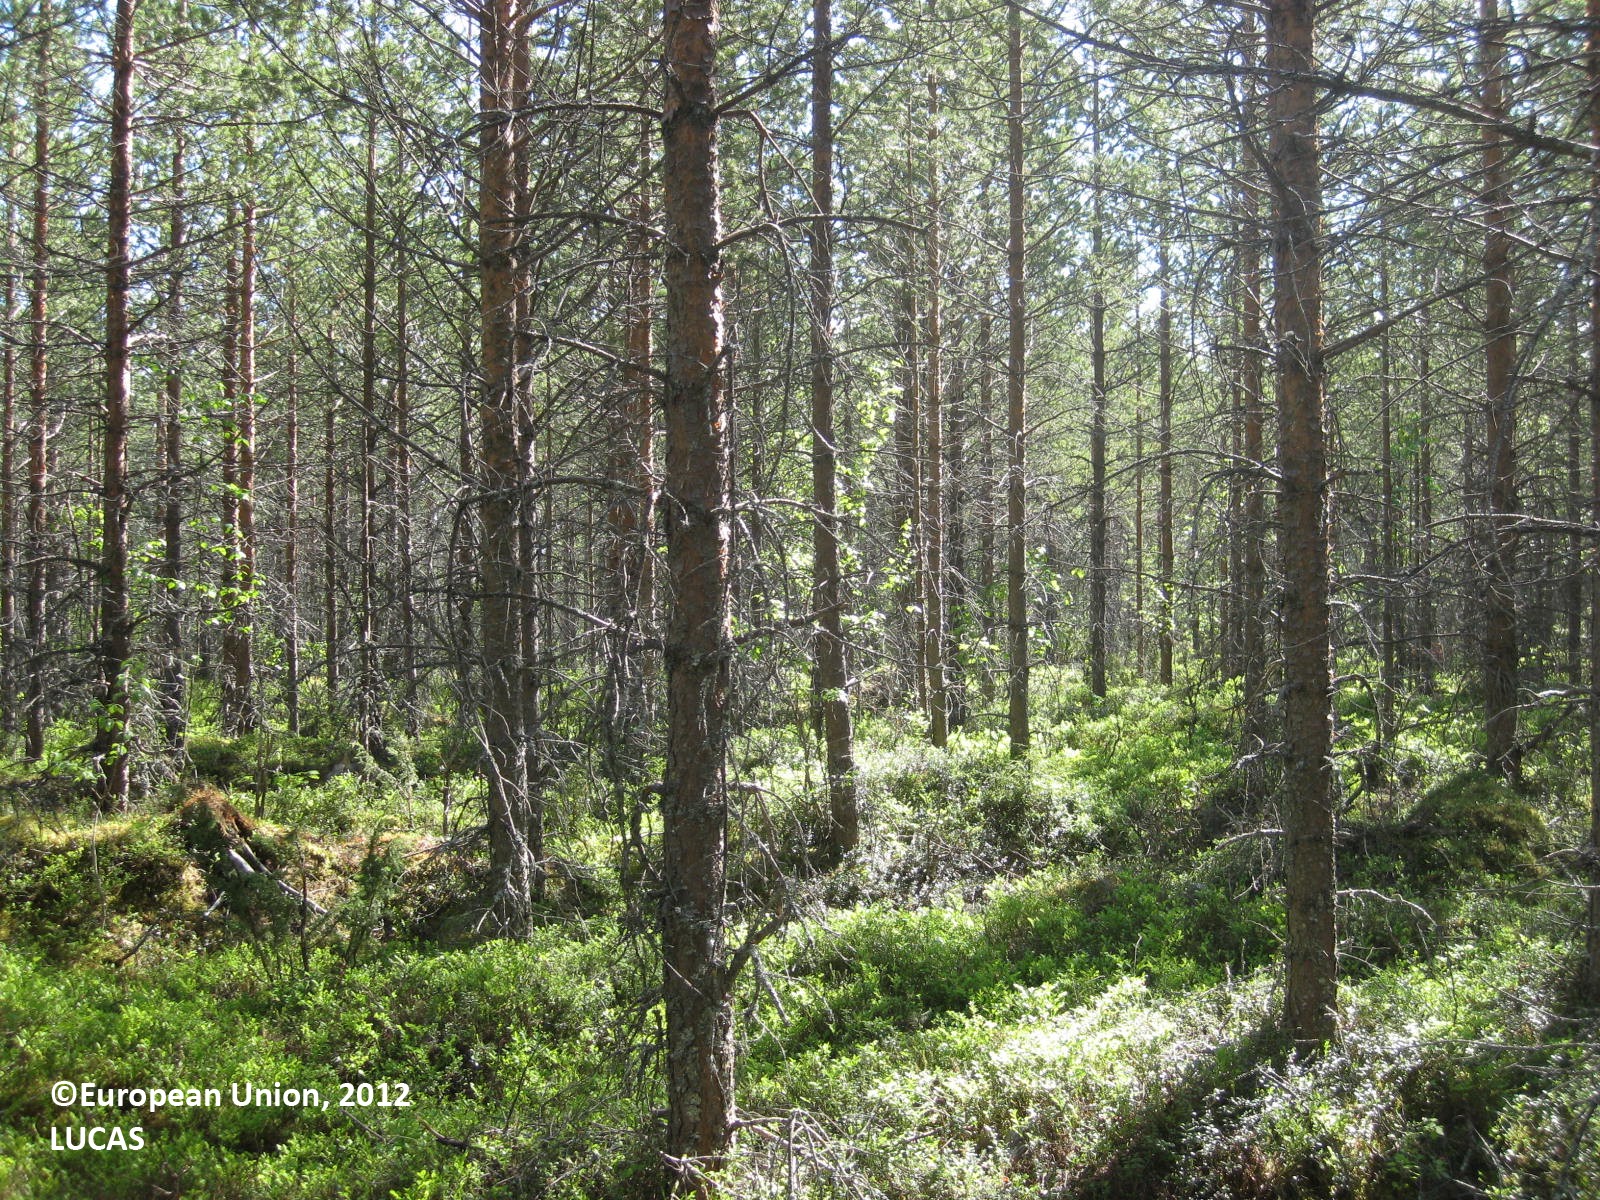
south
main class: Woodland
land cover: Pine dominated coniferous woodland
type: boreal forest
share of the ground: > 75 %
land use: Forestry
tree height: > 5 m
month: June
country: FI
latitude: 65.0340
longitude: 28.8010
